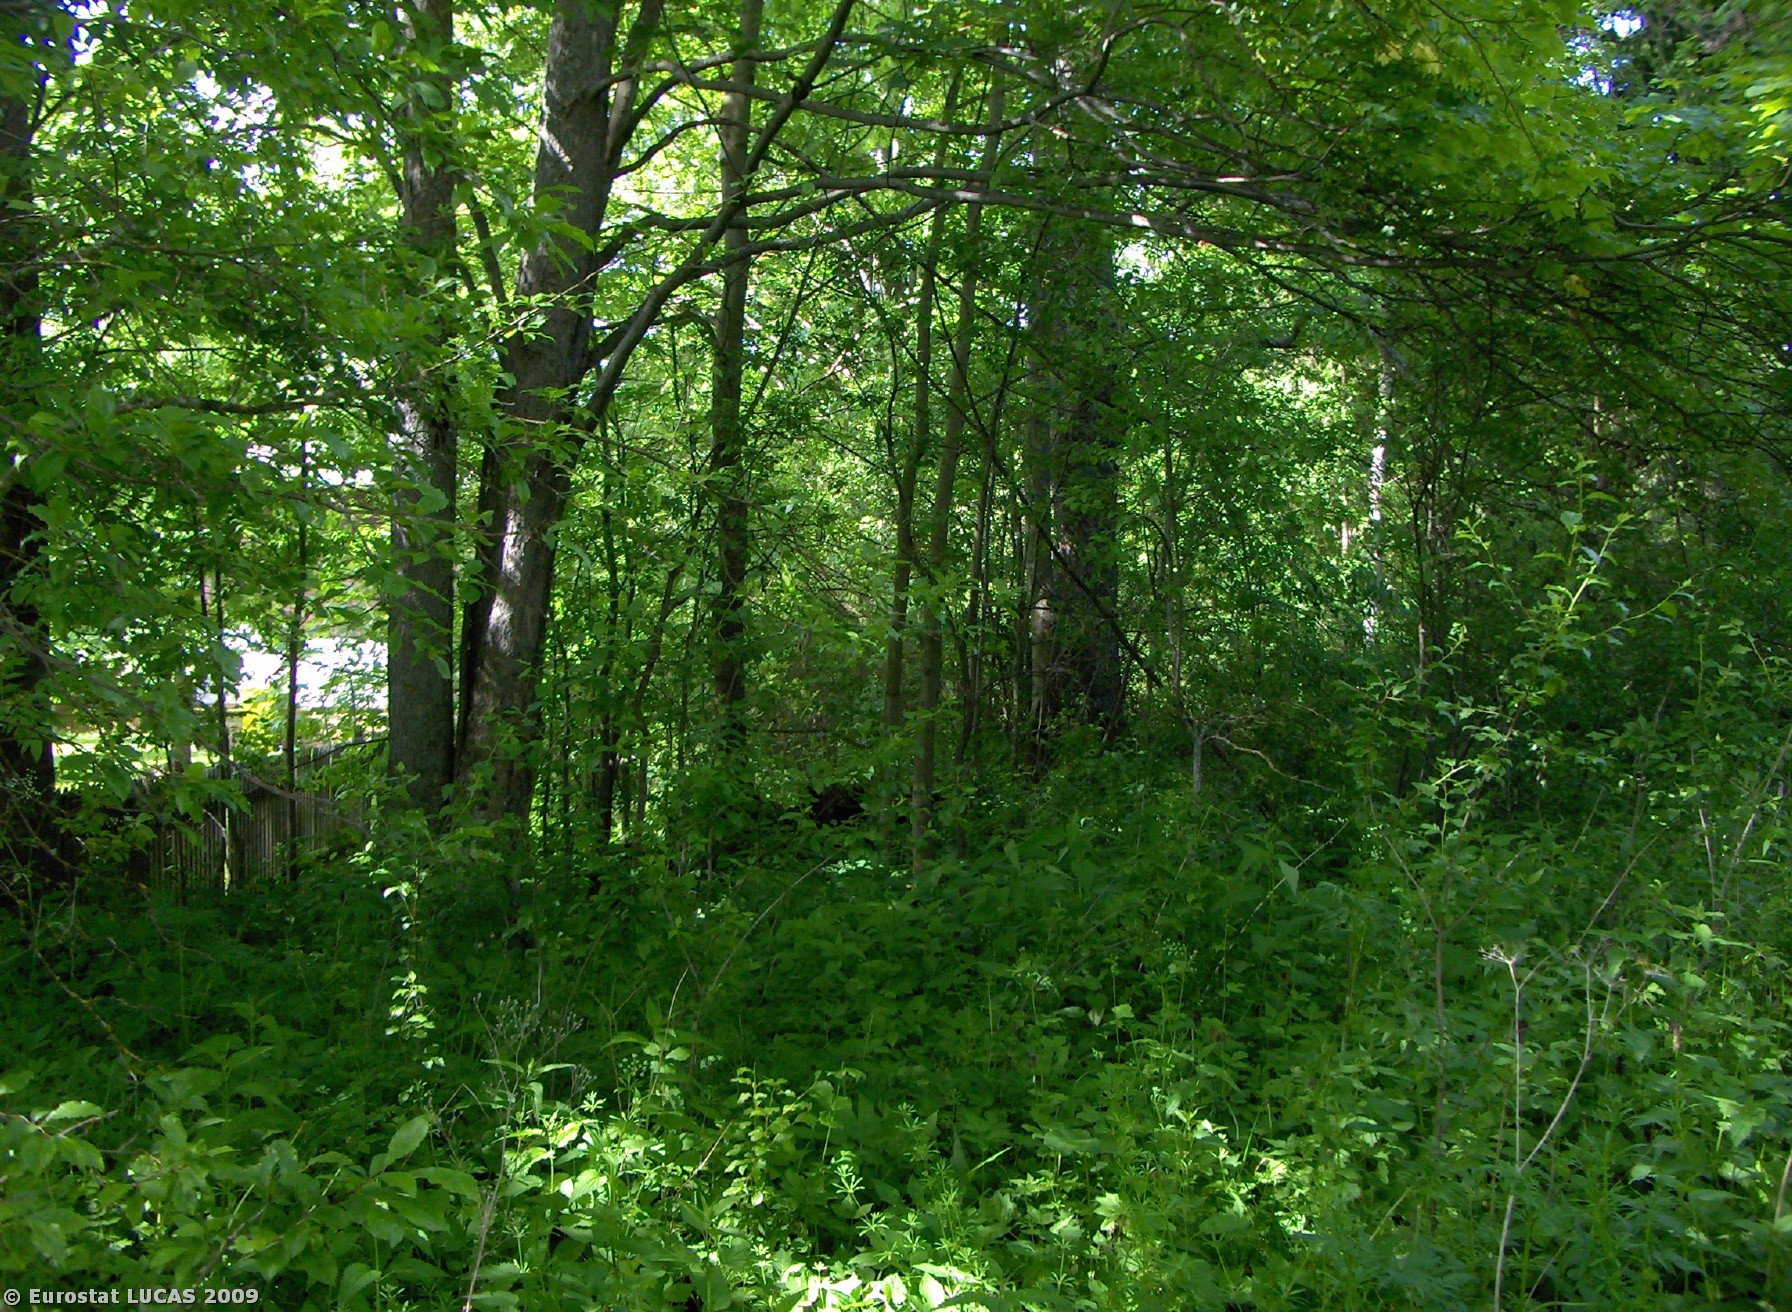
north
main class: Woodland
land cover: Broadleaved woodland
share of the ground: > 75 %
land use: Nature reserves
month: June
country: CZ
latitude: 48.9635
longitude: 13.9477
